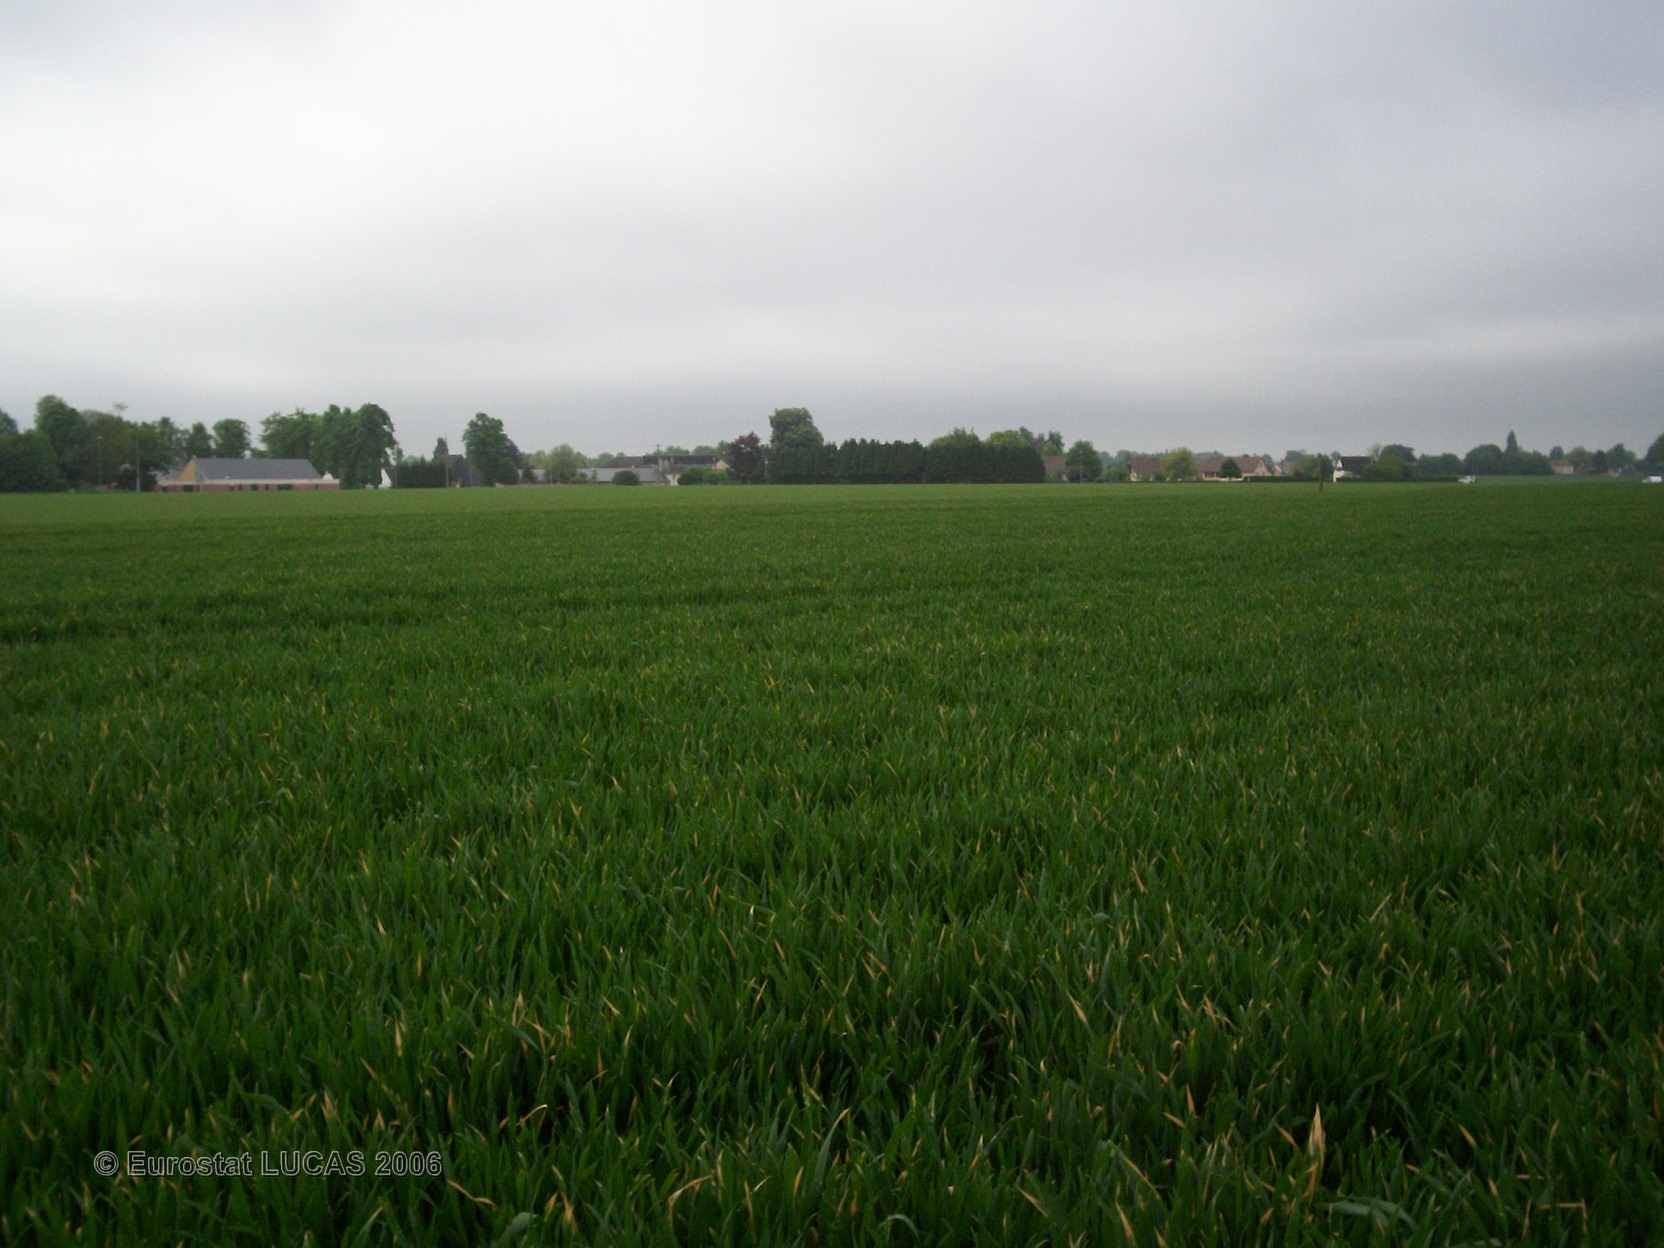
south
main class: Cropland
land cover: Common wheat
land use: Agriculture (excluding fallow land and kitchen gardens)
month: May
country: FR
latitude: 49.2648
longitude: 0.9768
